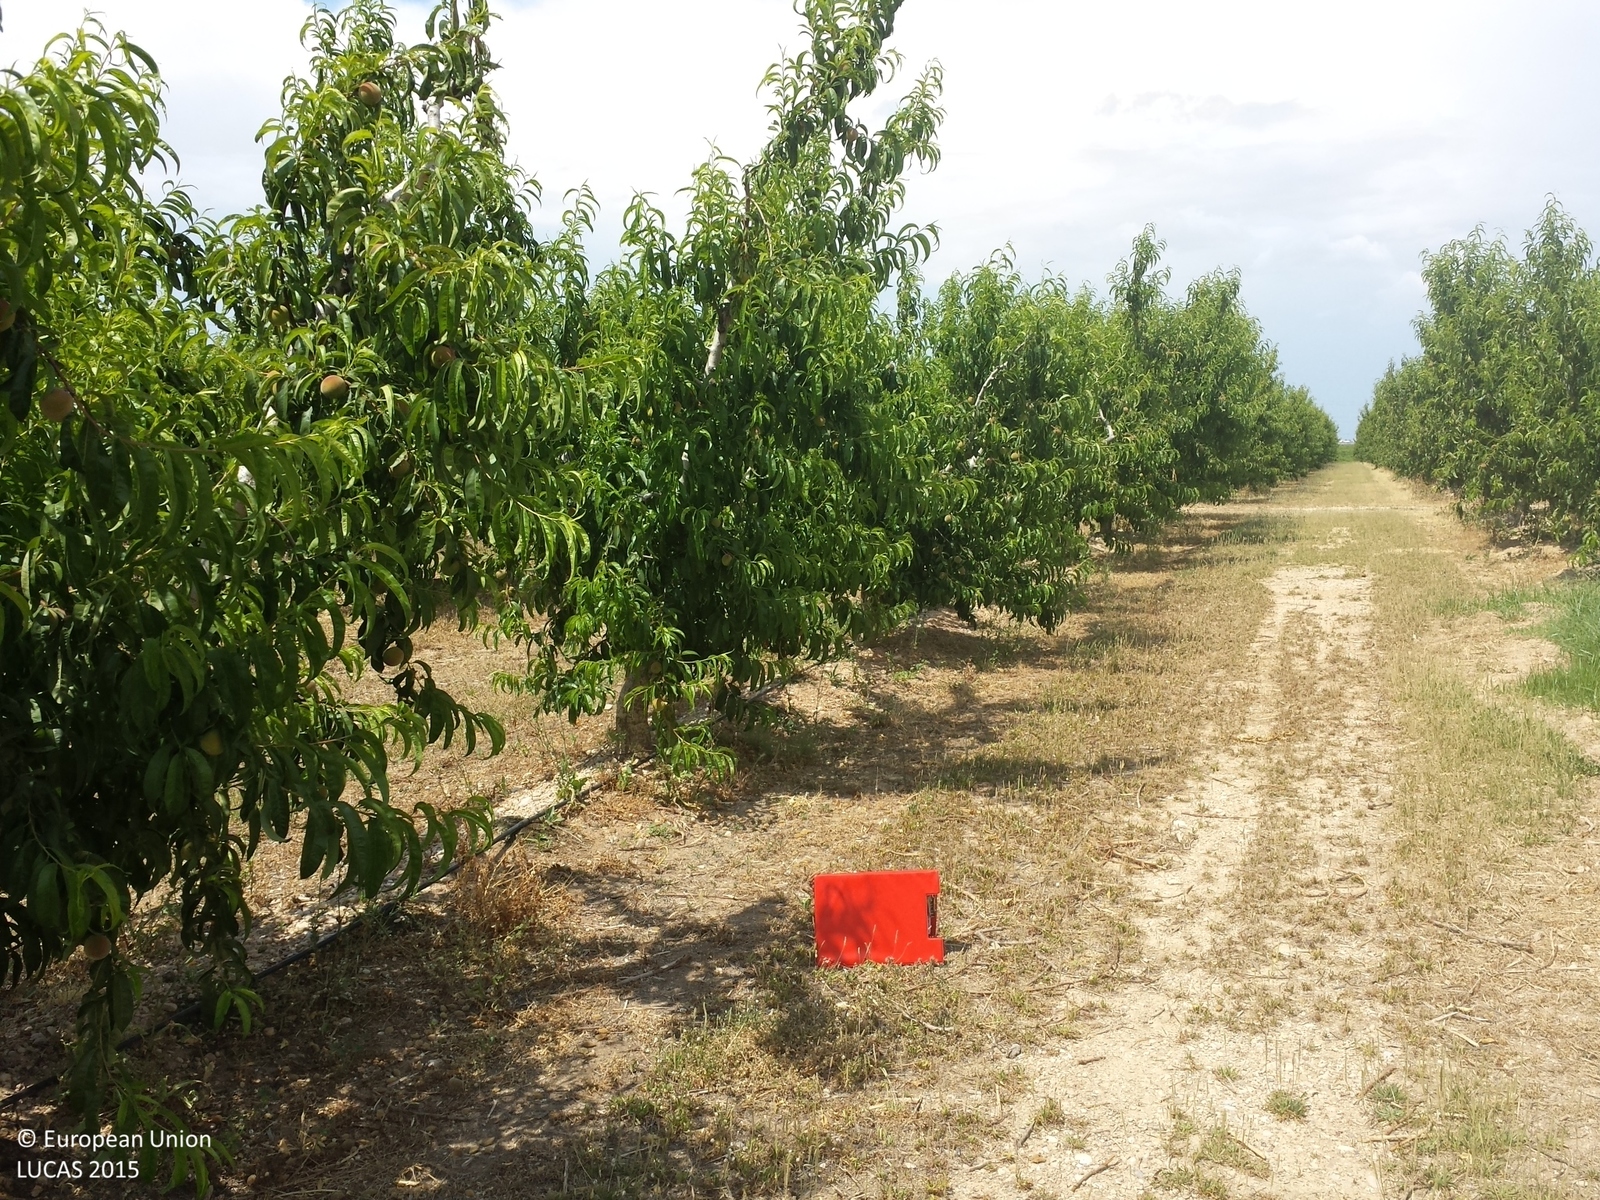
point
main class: Cropland
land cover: Other fruit trees and berries
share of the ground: 25 - 50 %
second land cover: Spontaneously vegetated surfaces
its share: 50 - 75 %
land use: Agriculture (excluding fallow land and kitchen gardens)
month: June
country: ES
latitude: 41.5392
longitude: 0.5544
